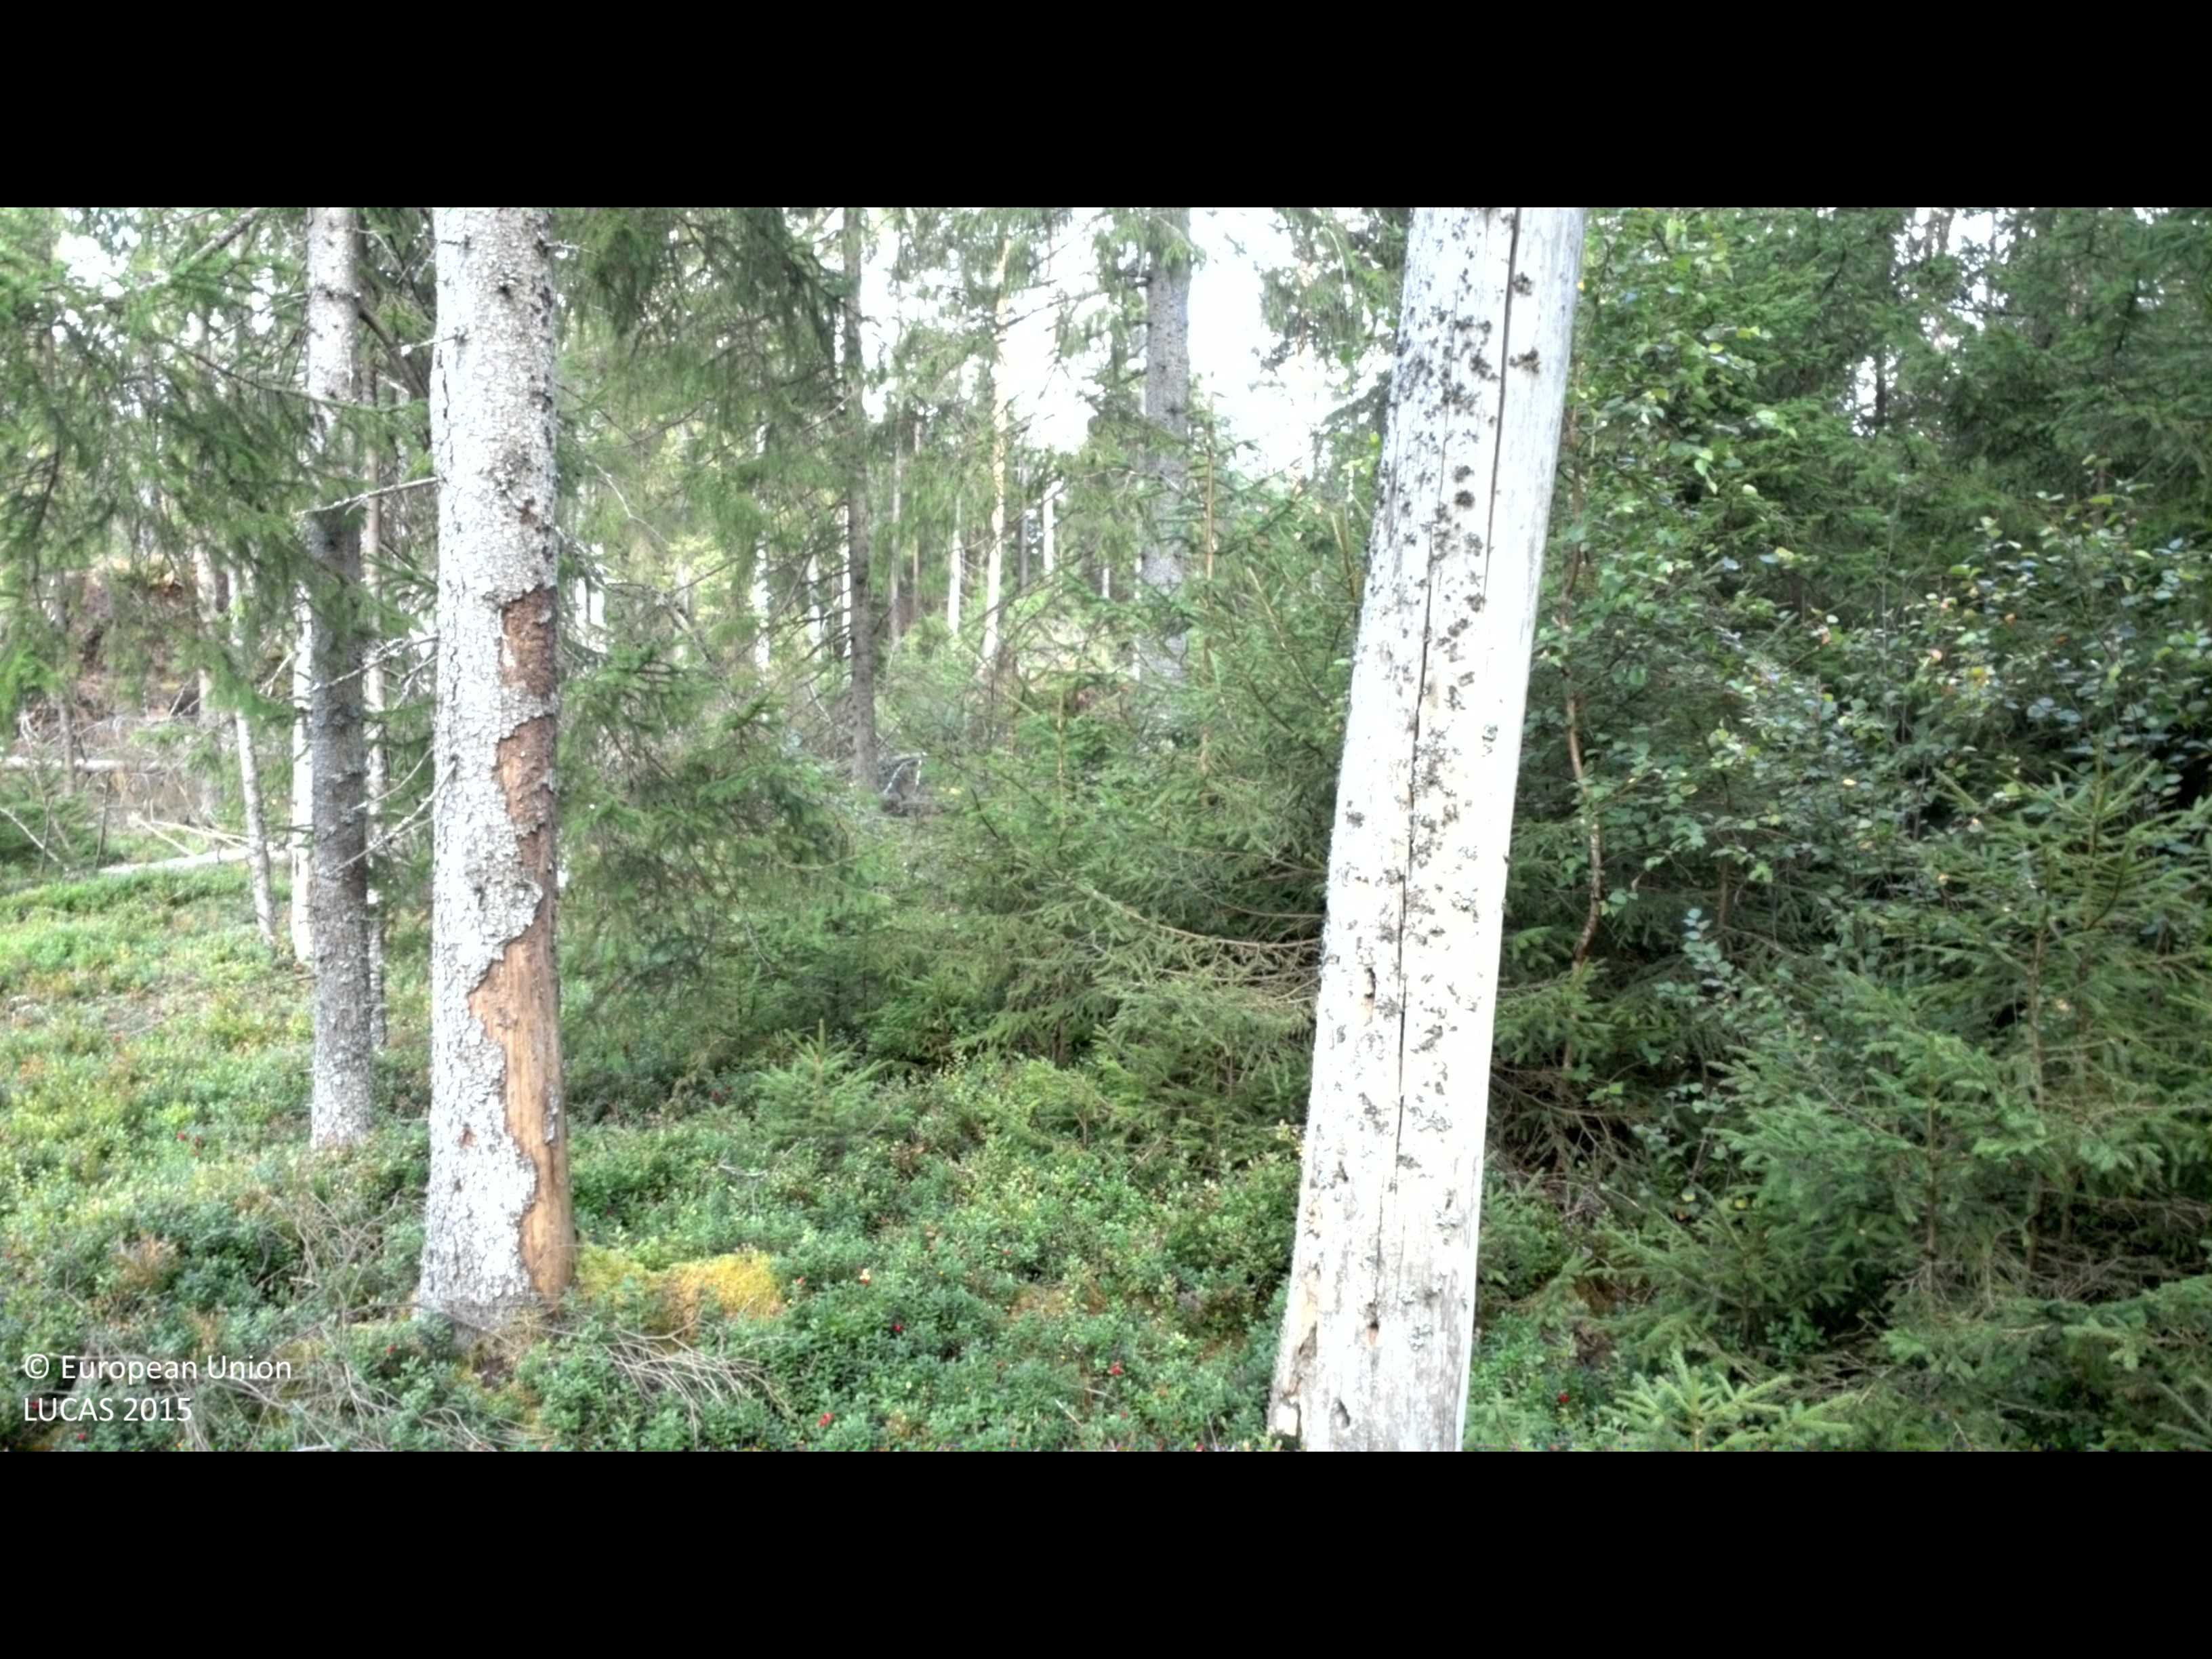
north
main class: Woodland
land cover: Spruce dominated coniferous woodland
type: boreal forest
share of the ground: 50 - 75 %
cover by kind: coniferous forest trees 70 %, shrubs 30 %
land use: Forestry
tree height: > 5 m
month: August
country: SE
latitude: 57.1751
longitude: 13.8169
